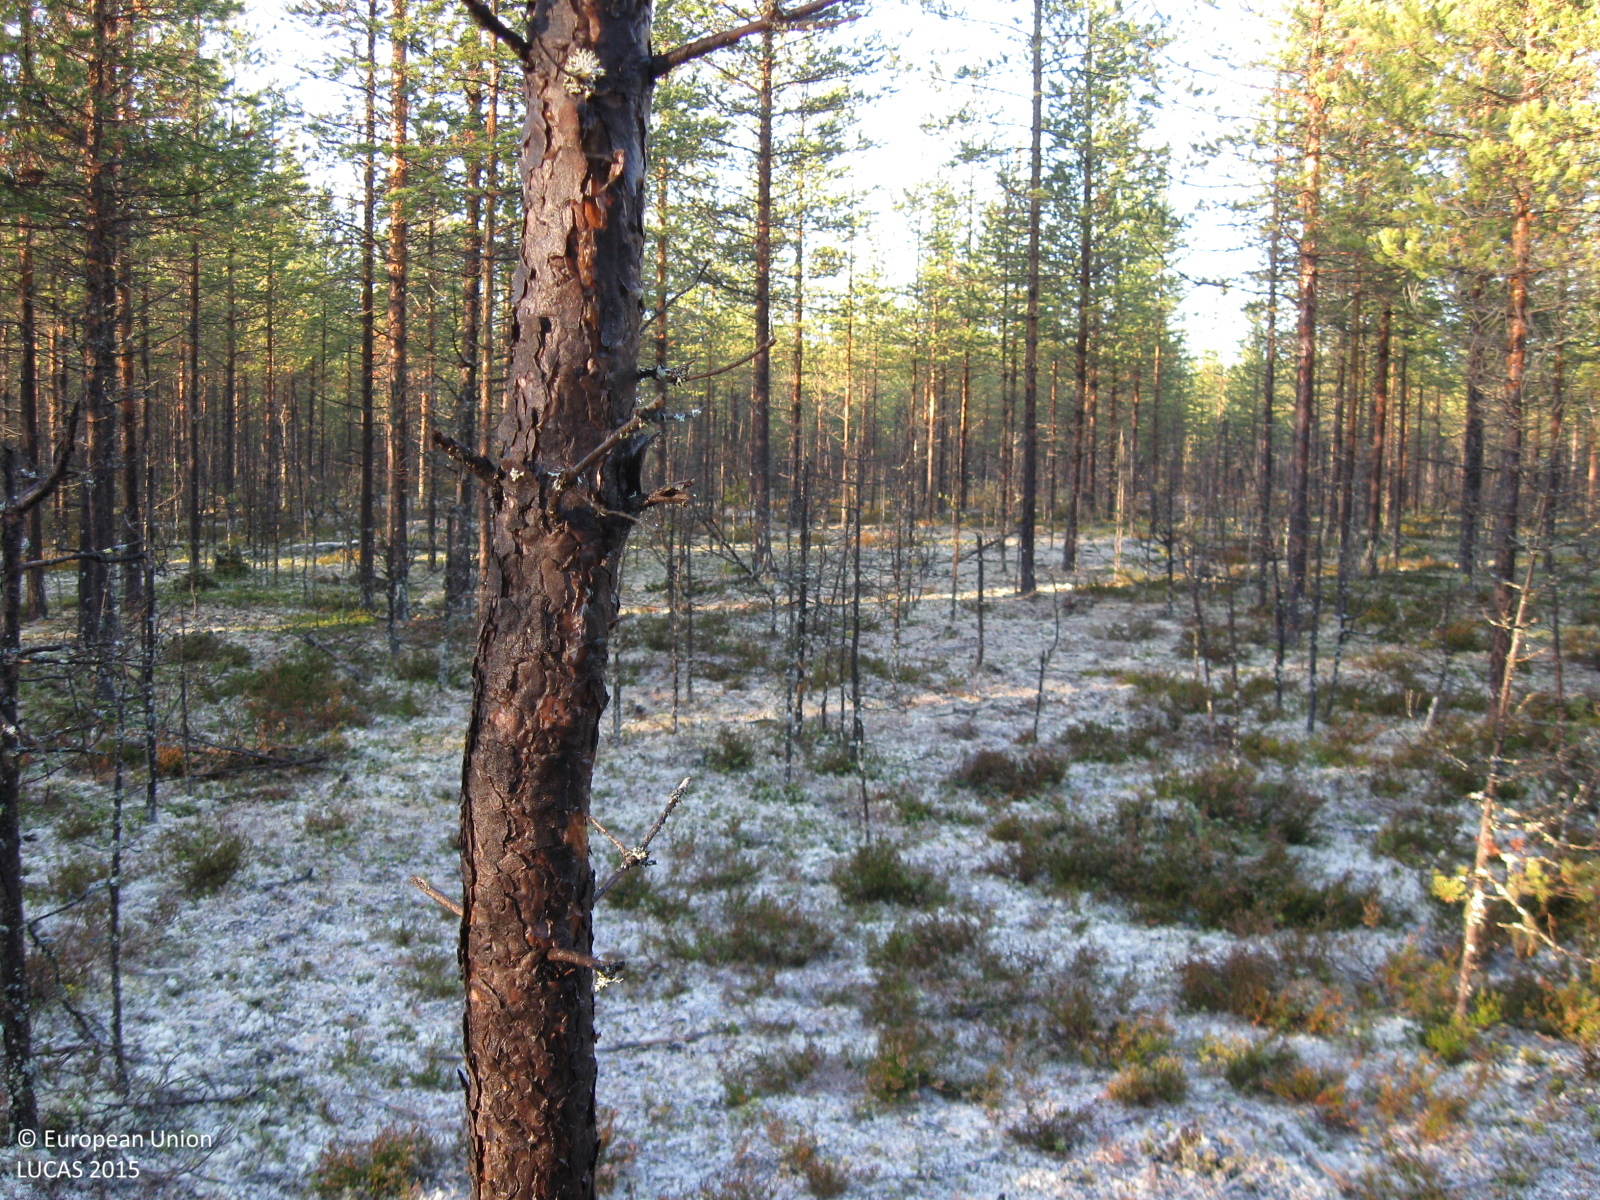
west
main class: Woodland
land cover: Pine dominated coniferous woodland
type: boreal forest
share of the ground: 50 - 75 %
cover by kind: coniferous forest trees 55 %, lichens and mosses 30 %, shrubs 10 %, herbaceous plants 5 %
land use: Forestry
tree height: > 5 m
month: October
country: SE
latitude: 66.2738
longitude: 20.8518
